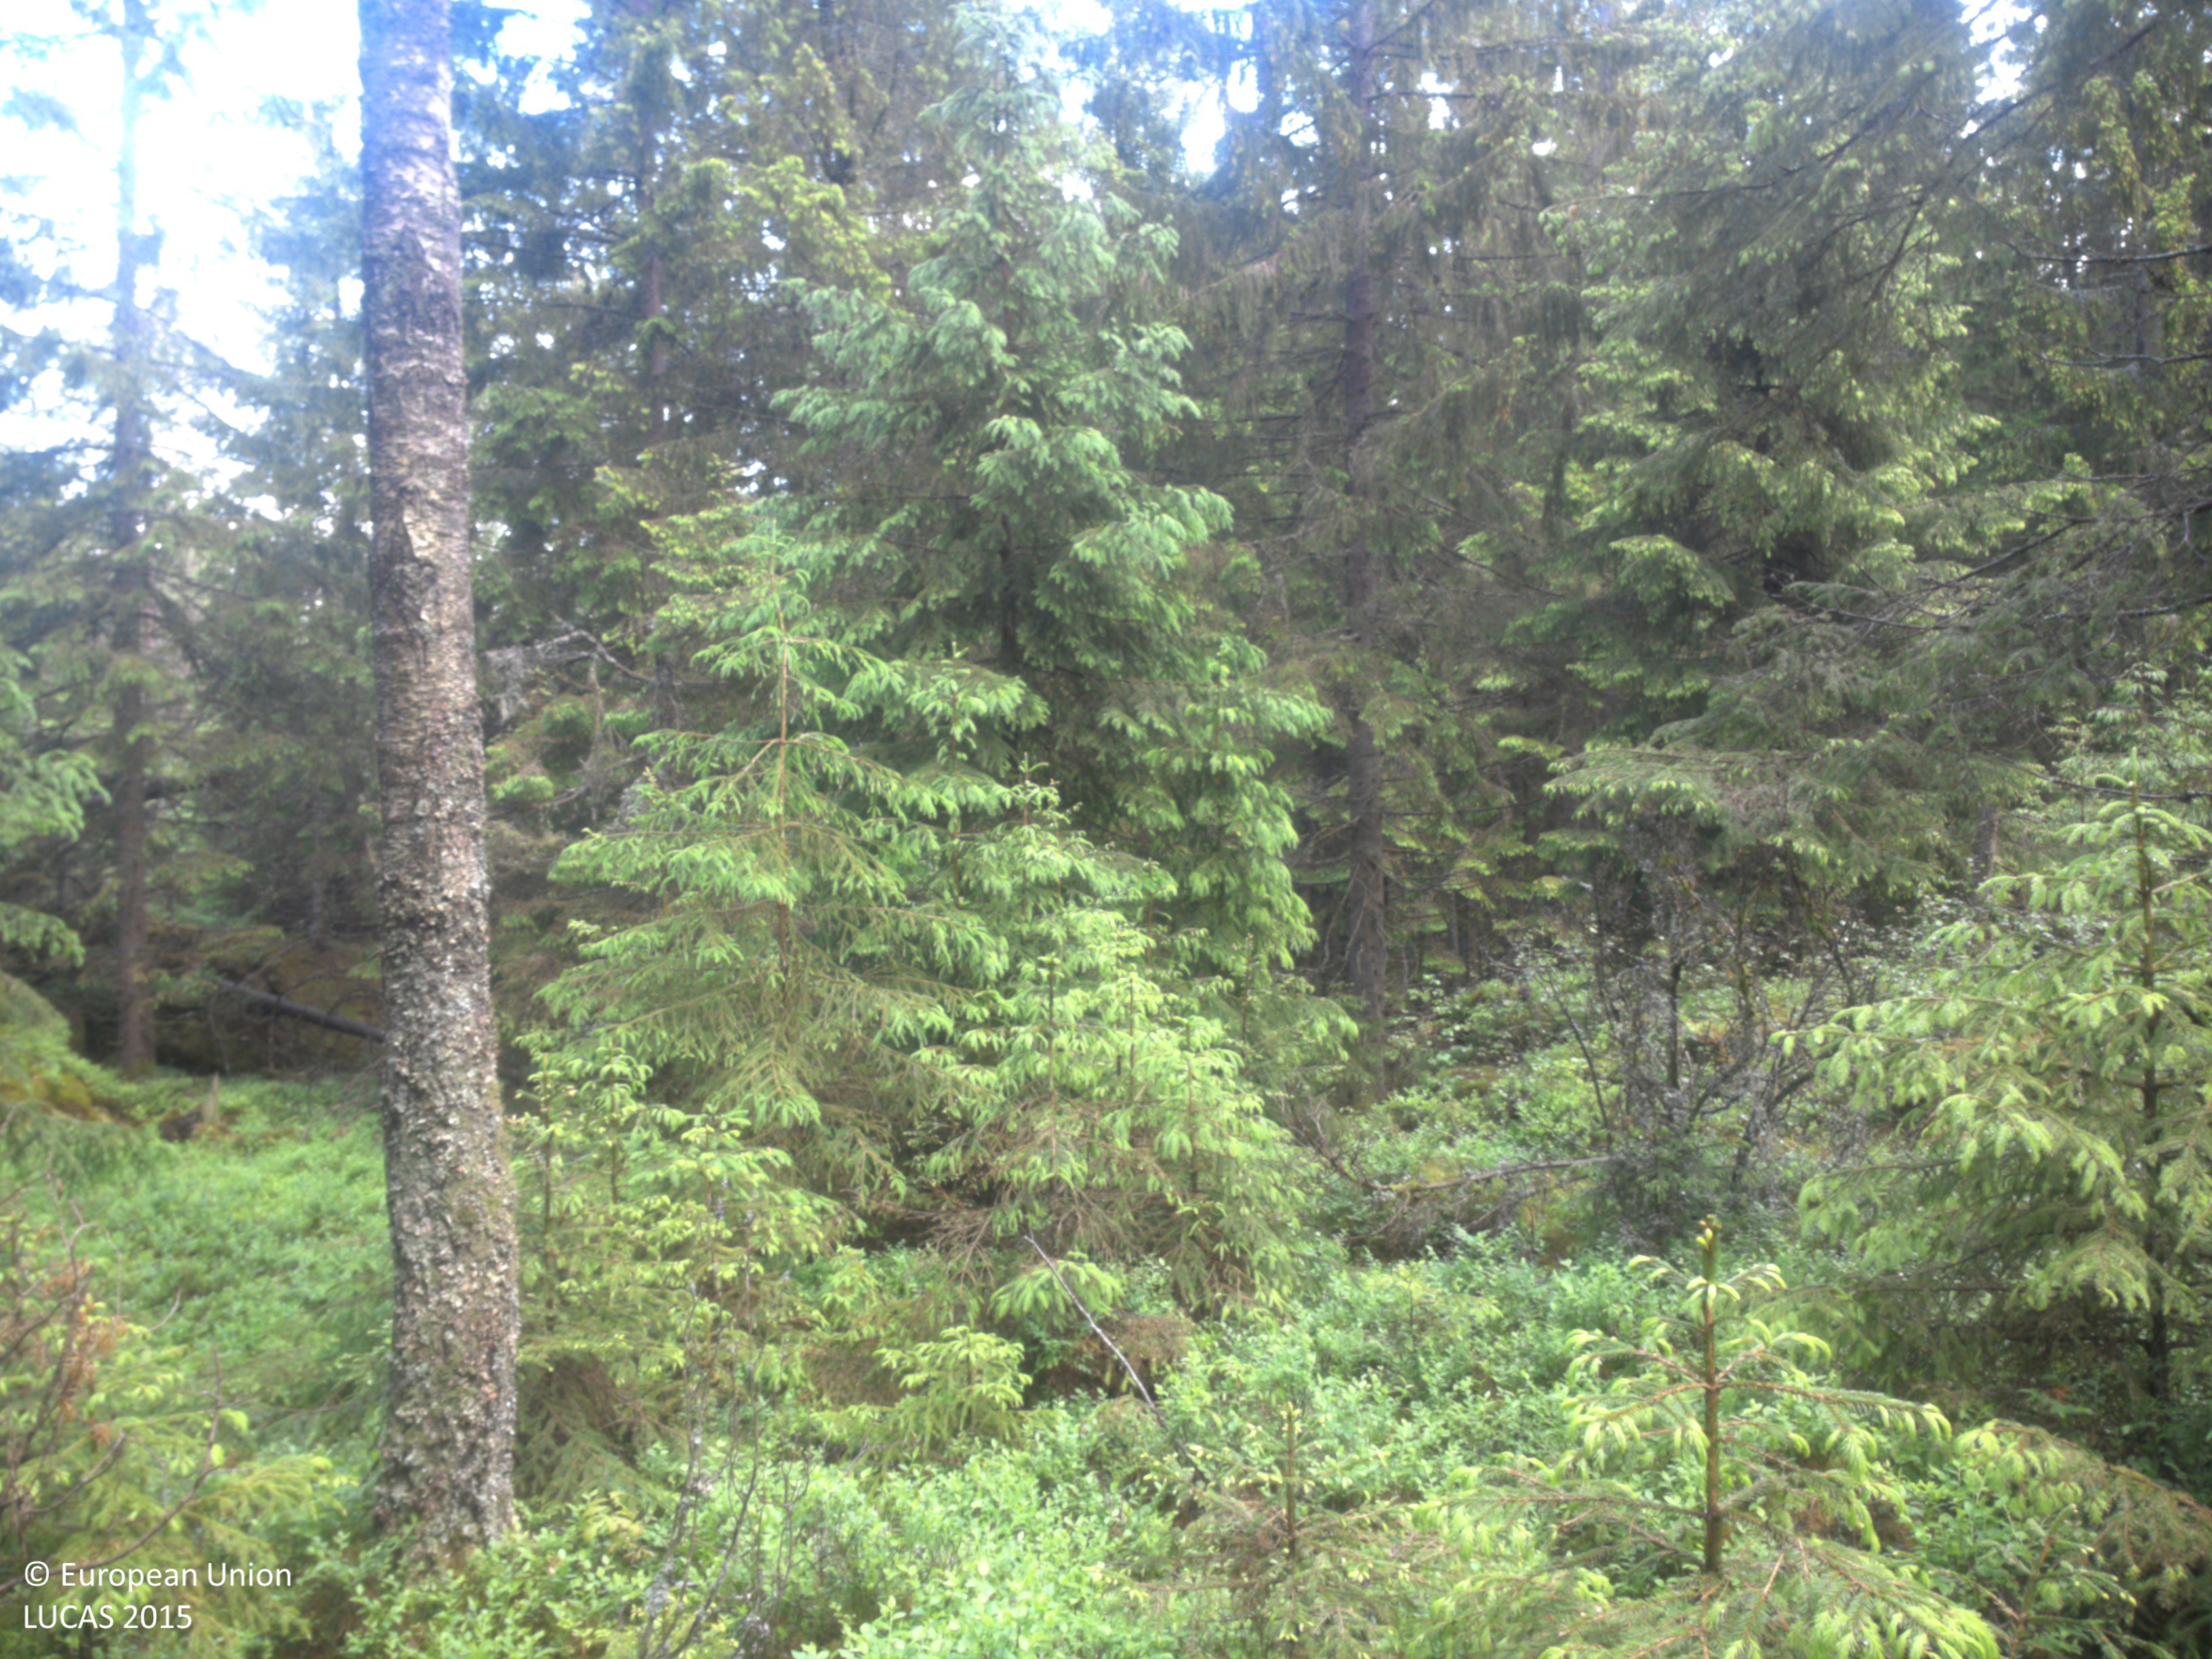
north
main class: Woodland
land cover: Spruce dominated coniferous woodland
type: boreal forest
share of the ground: 50 - 75 %
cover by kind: coniferous forest trees 50 %, lichens and mosses 30 %, shrubs 20 %
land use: Forestry
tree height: > 5 m
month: June
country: SE
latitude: 58.4054
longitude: 11.7932
